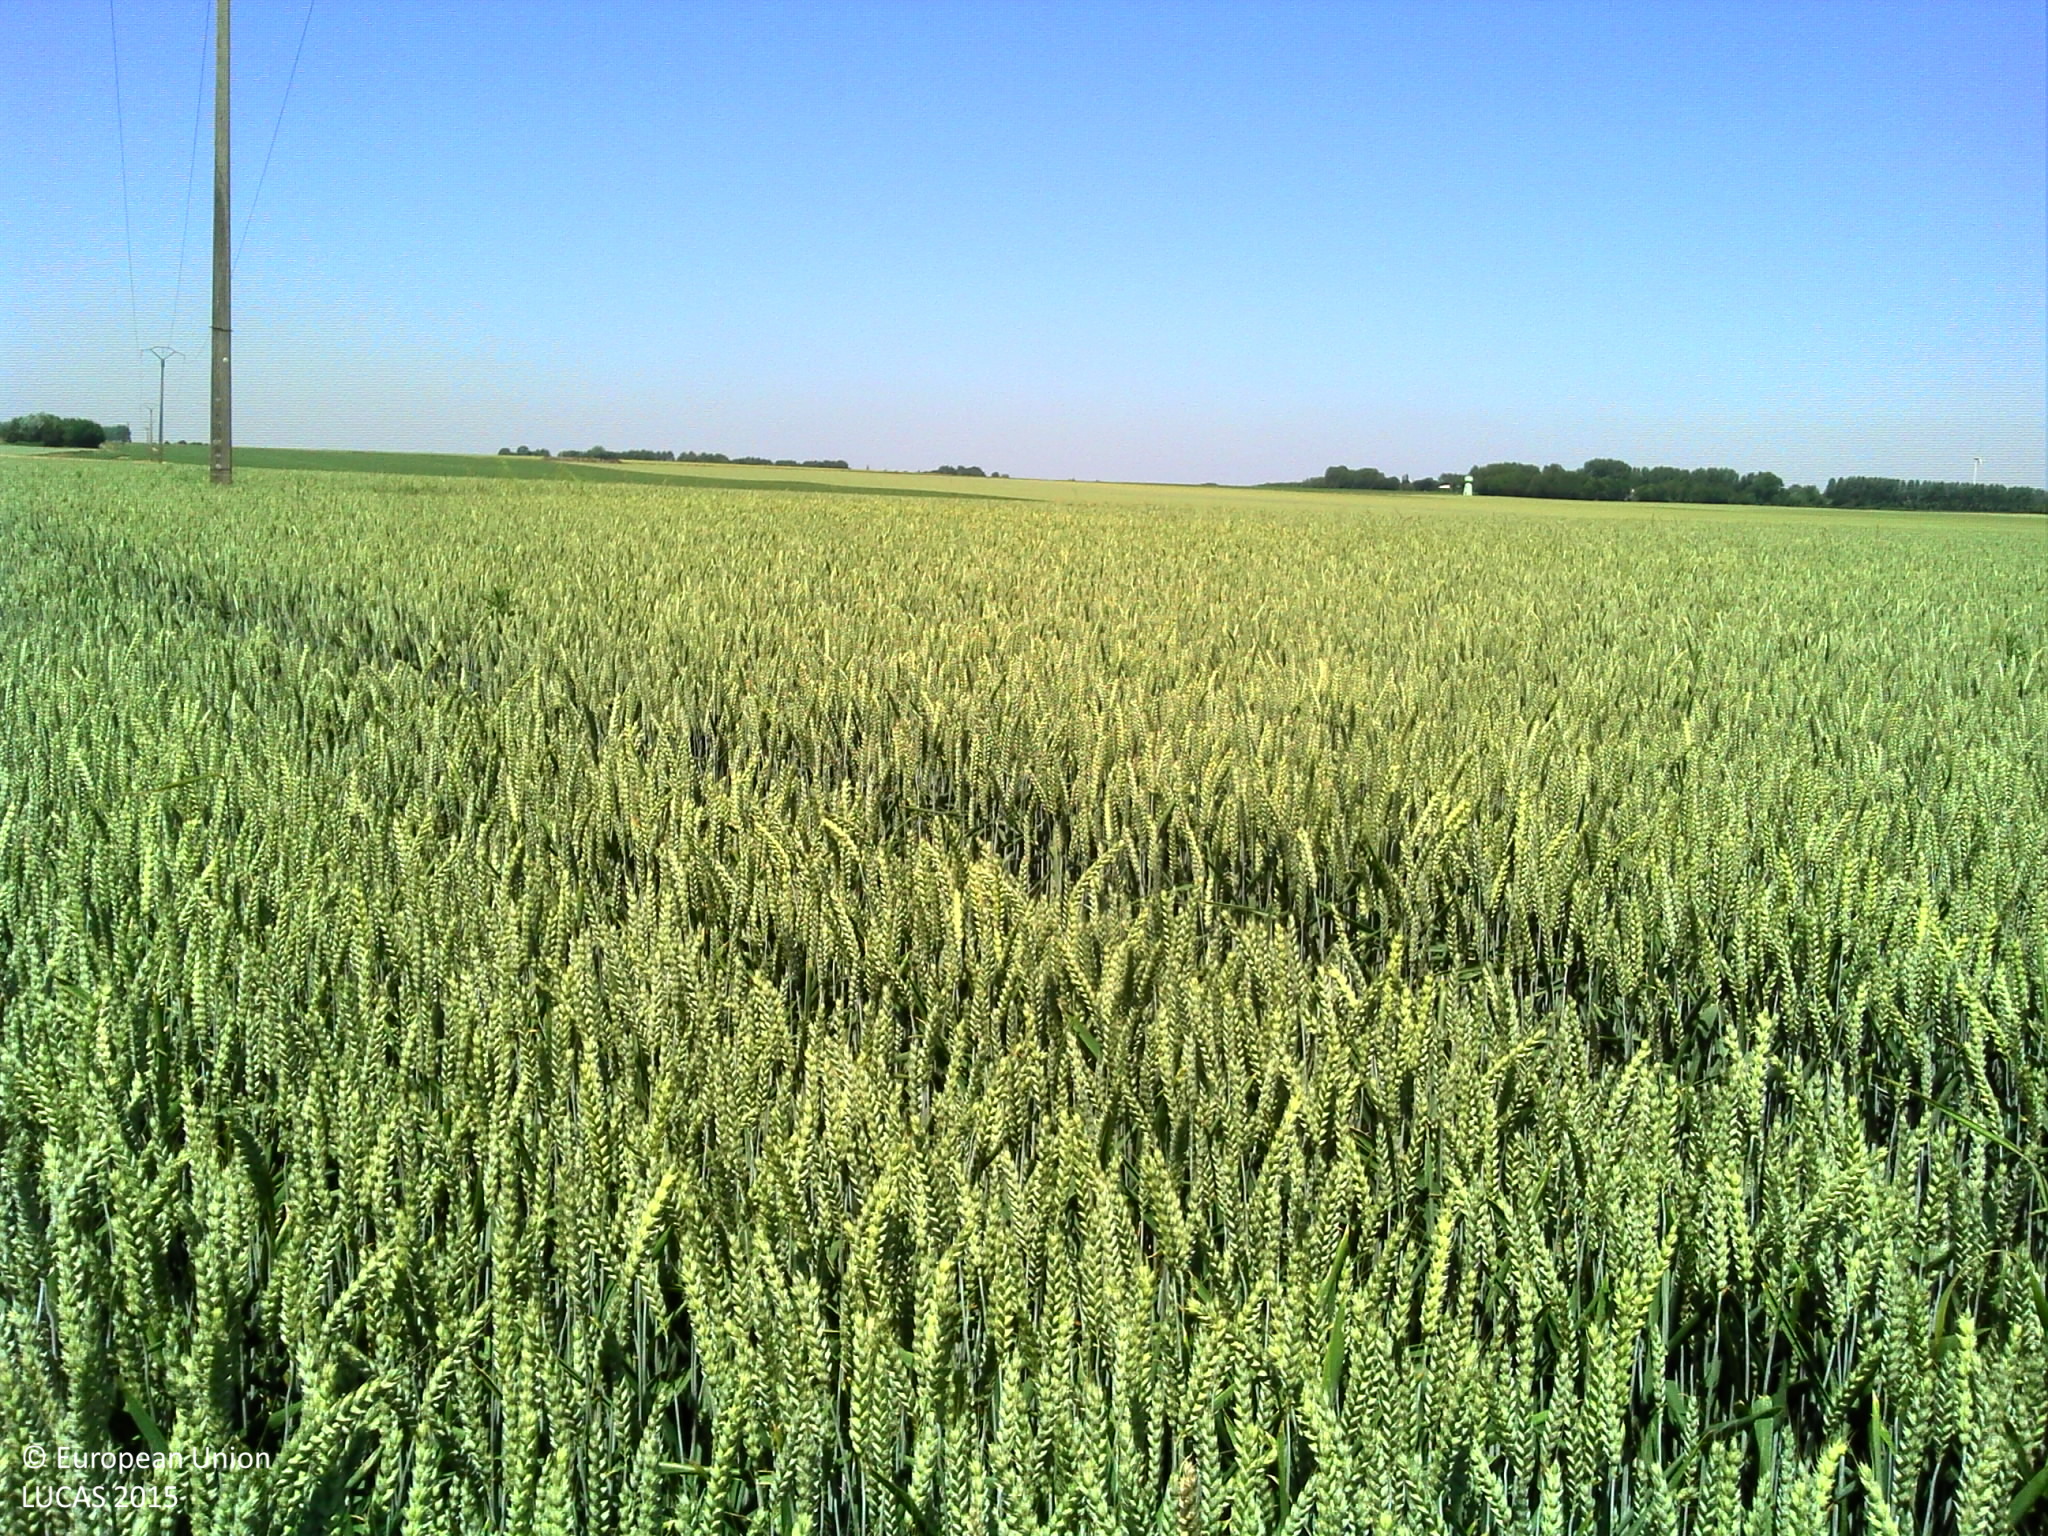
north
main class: Cropland
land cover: Common wheat
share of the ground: > 75 %
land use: Agriculture (excluding fallow land and kitchen gardens)
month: June
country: FR
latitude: 50.3269
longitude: 2.3874
